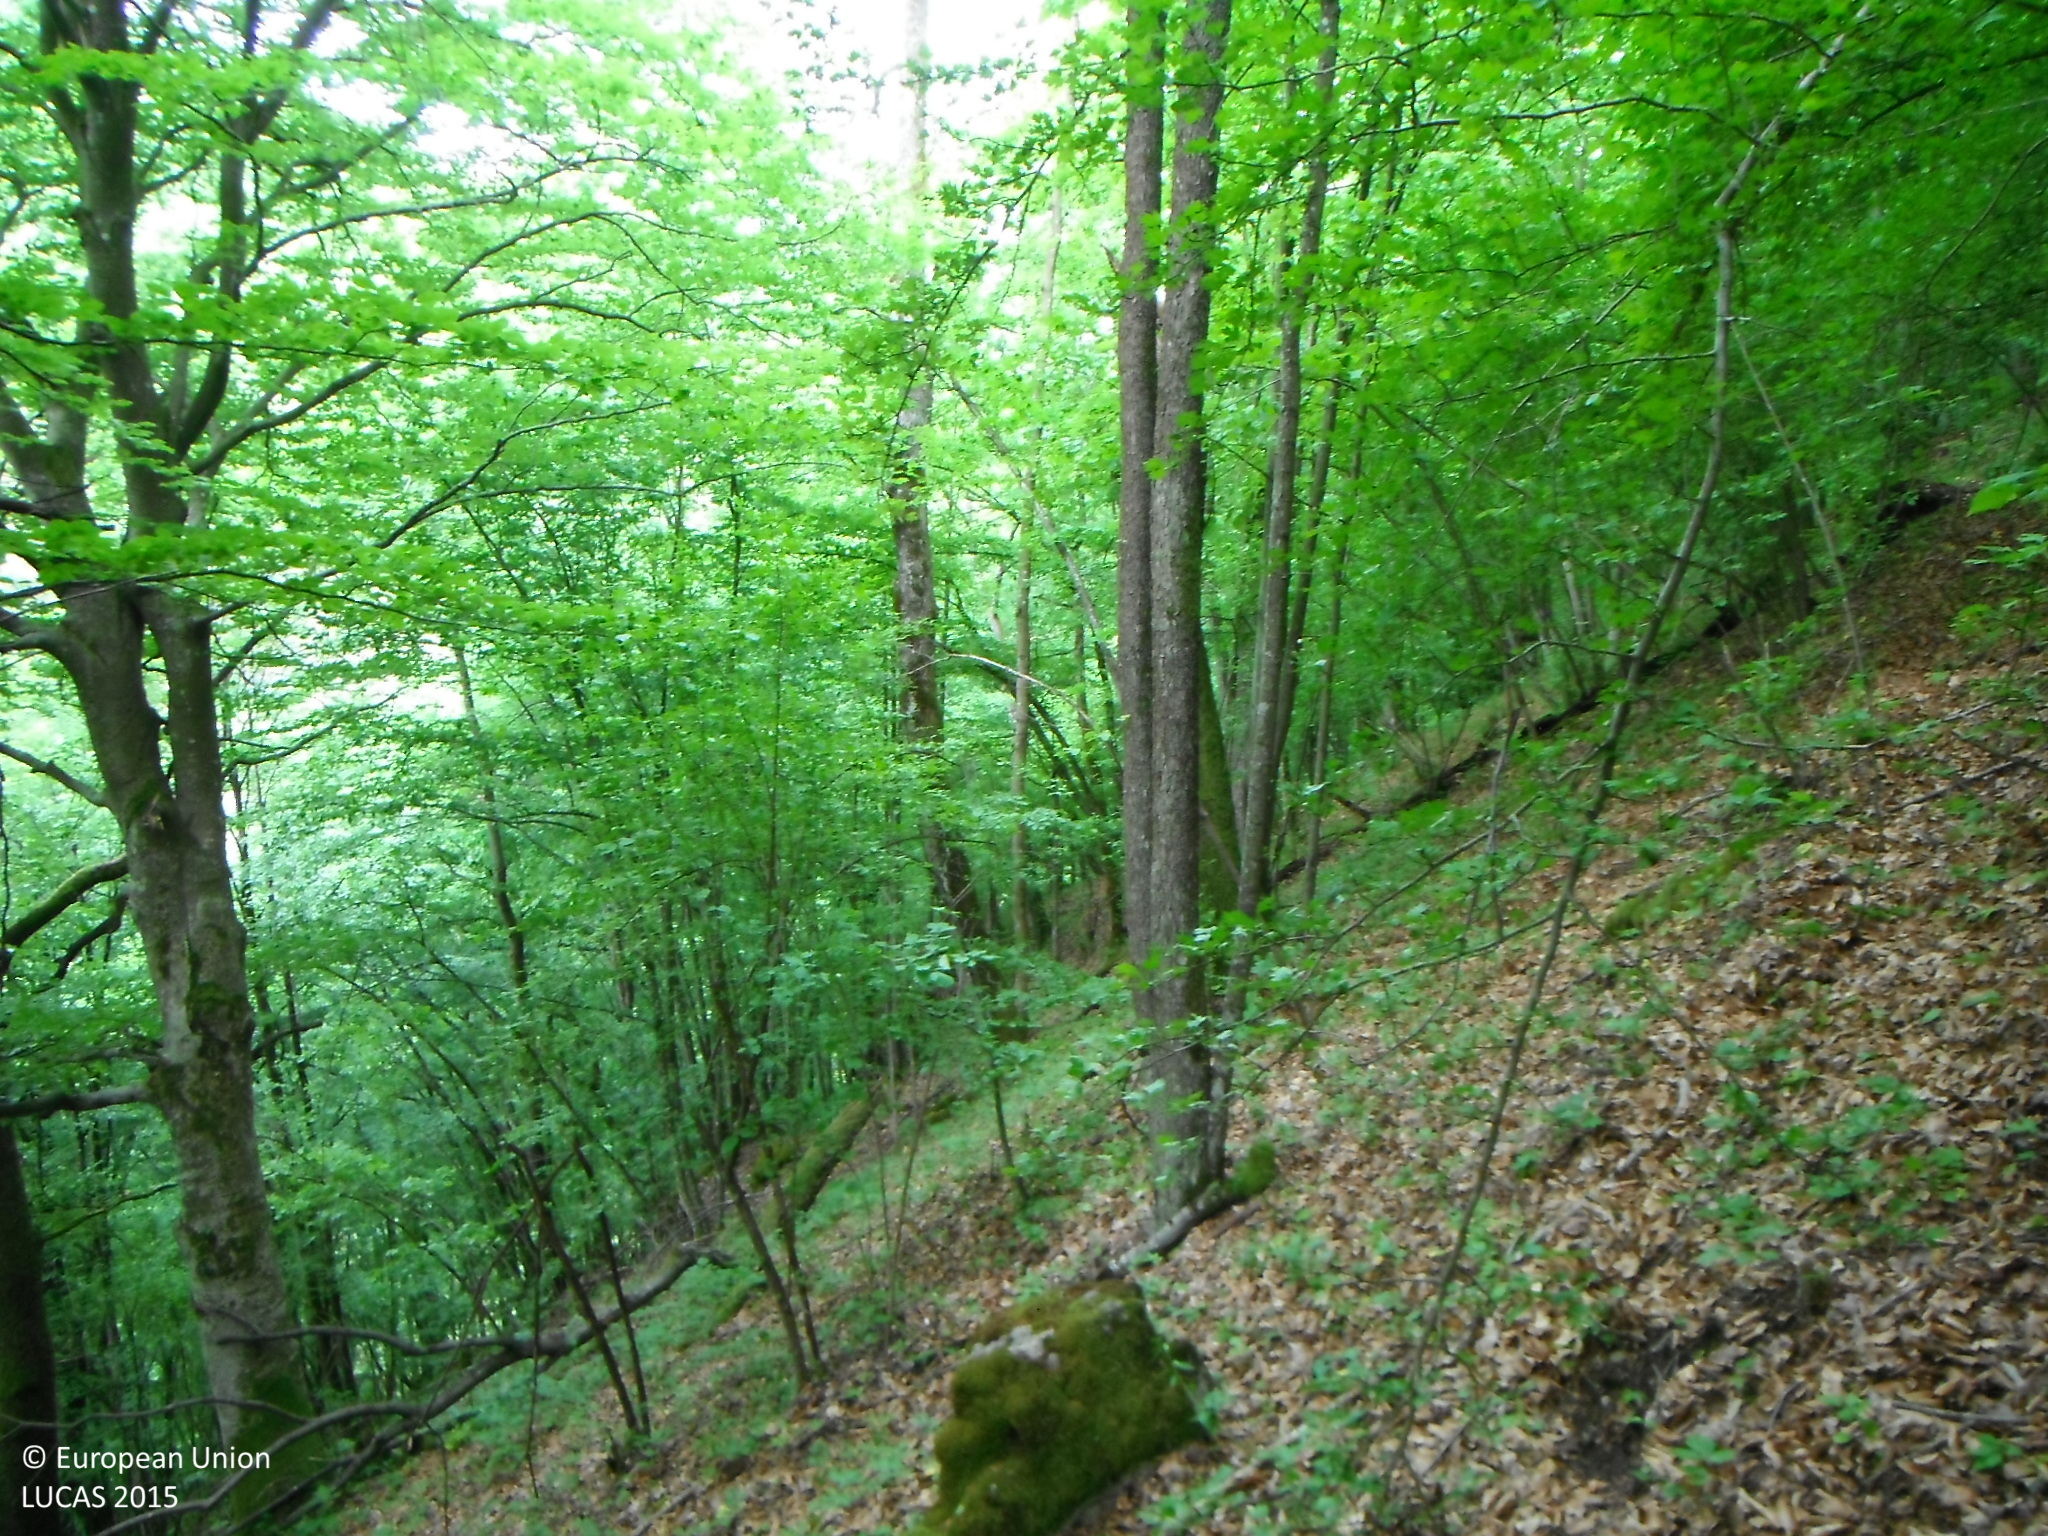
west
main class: Woodland
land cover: Broadleaved woodland
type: beech forest
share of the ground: > 75 %
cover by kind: broadleaved forest trees 100 %
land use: Forestry
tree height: > 5 m
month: June
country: SK
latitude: 48.7544
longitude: 19.2865
